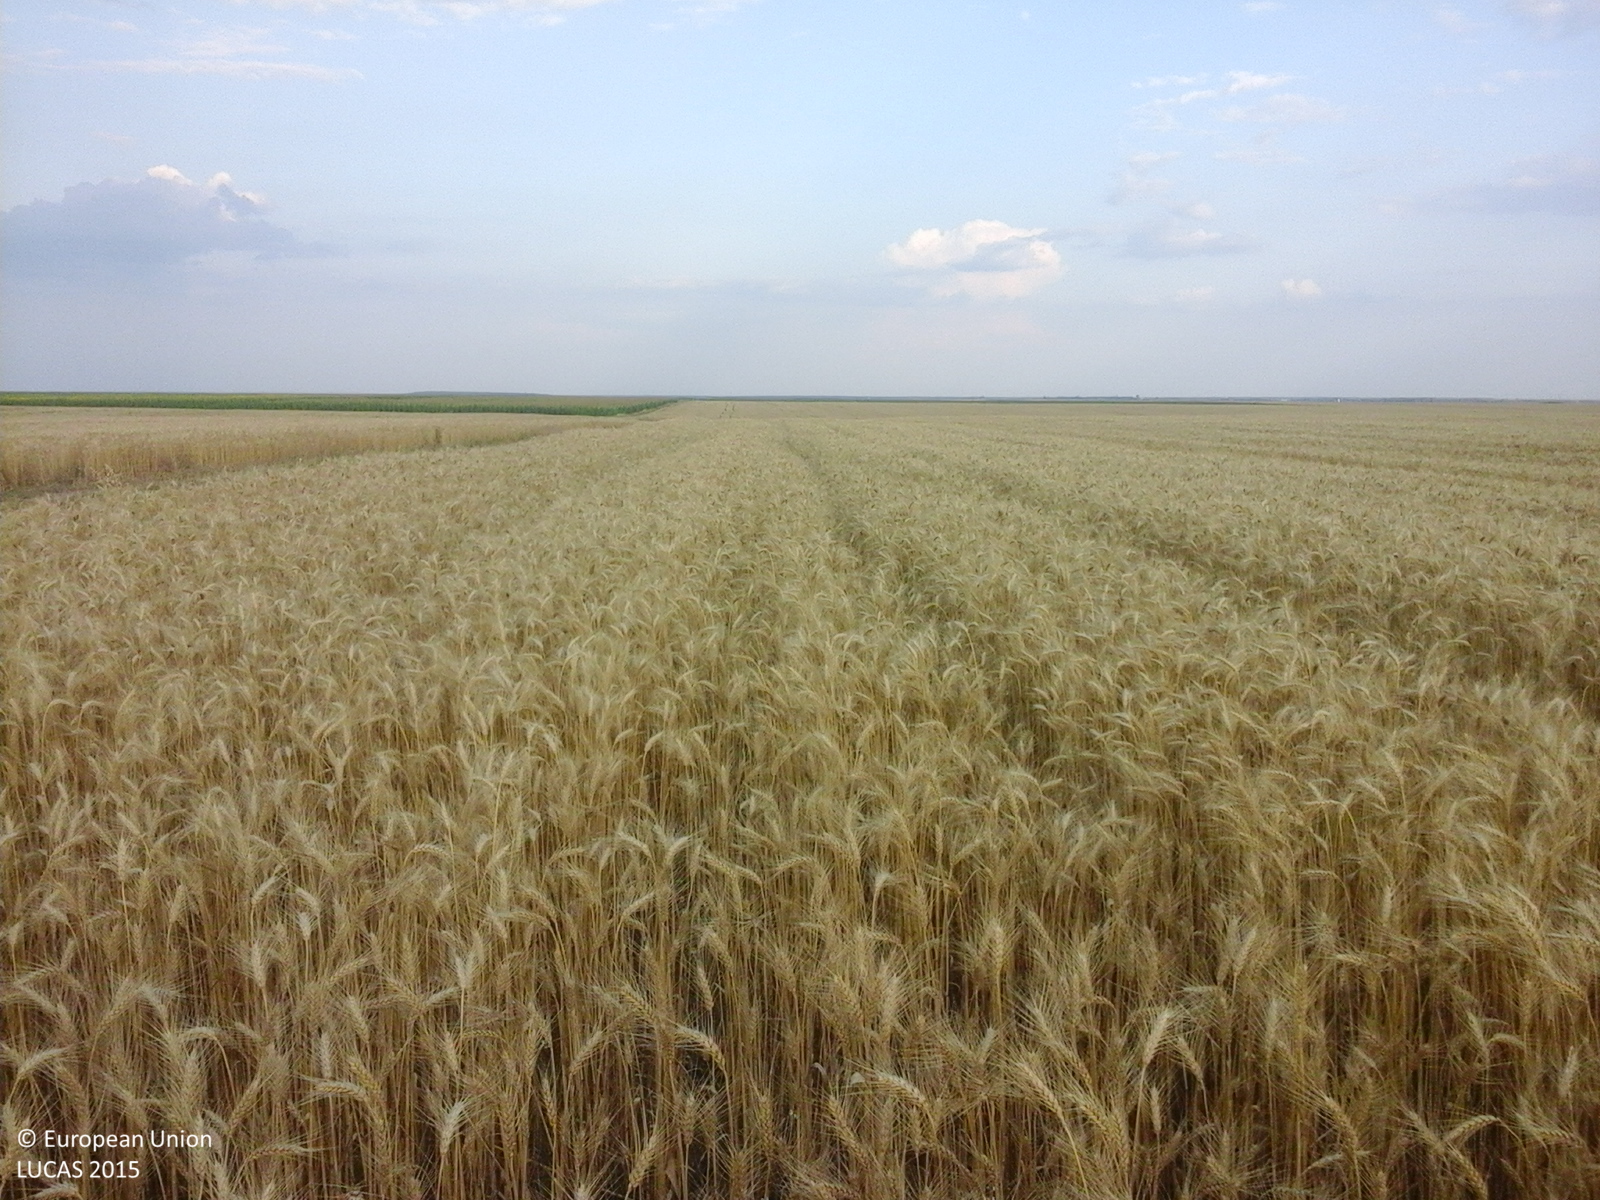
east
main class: Cropland
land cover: Common wheat
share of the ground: > 75 %
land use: Agriculture (excluding fallow land and kitchen gardens)
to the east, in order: Common wheat; Tracks; Common wheat
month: July
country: RO
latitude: 44.1941
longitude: 25.9258
